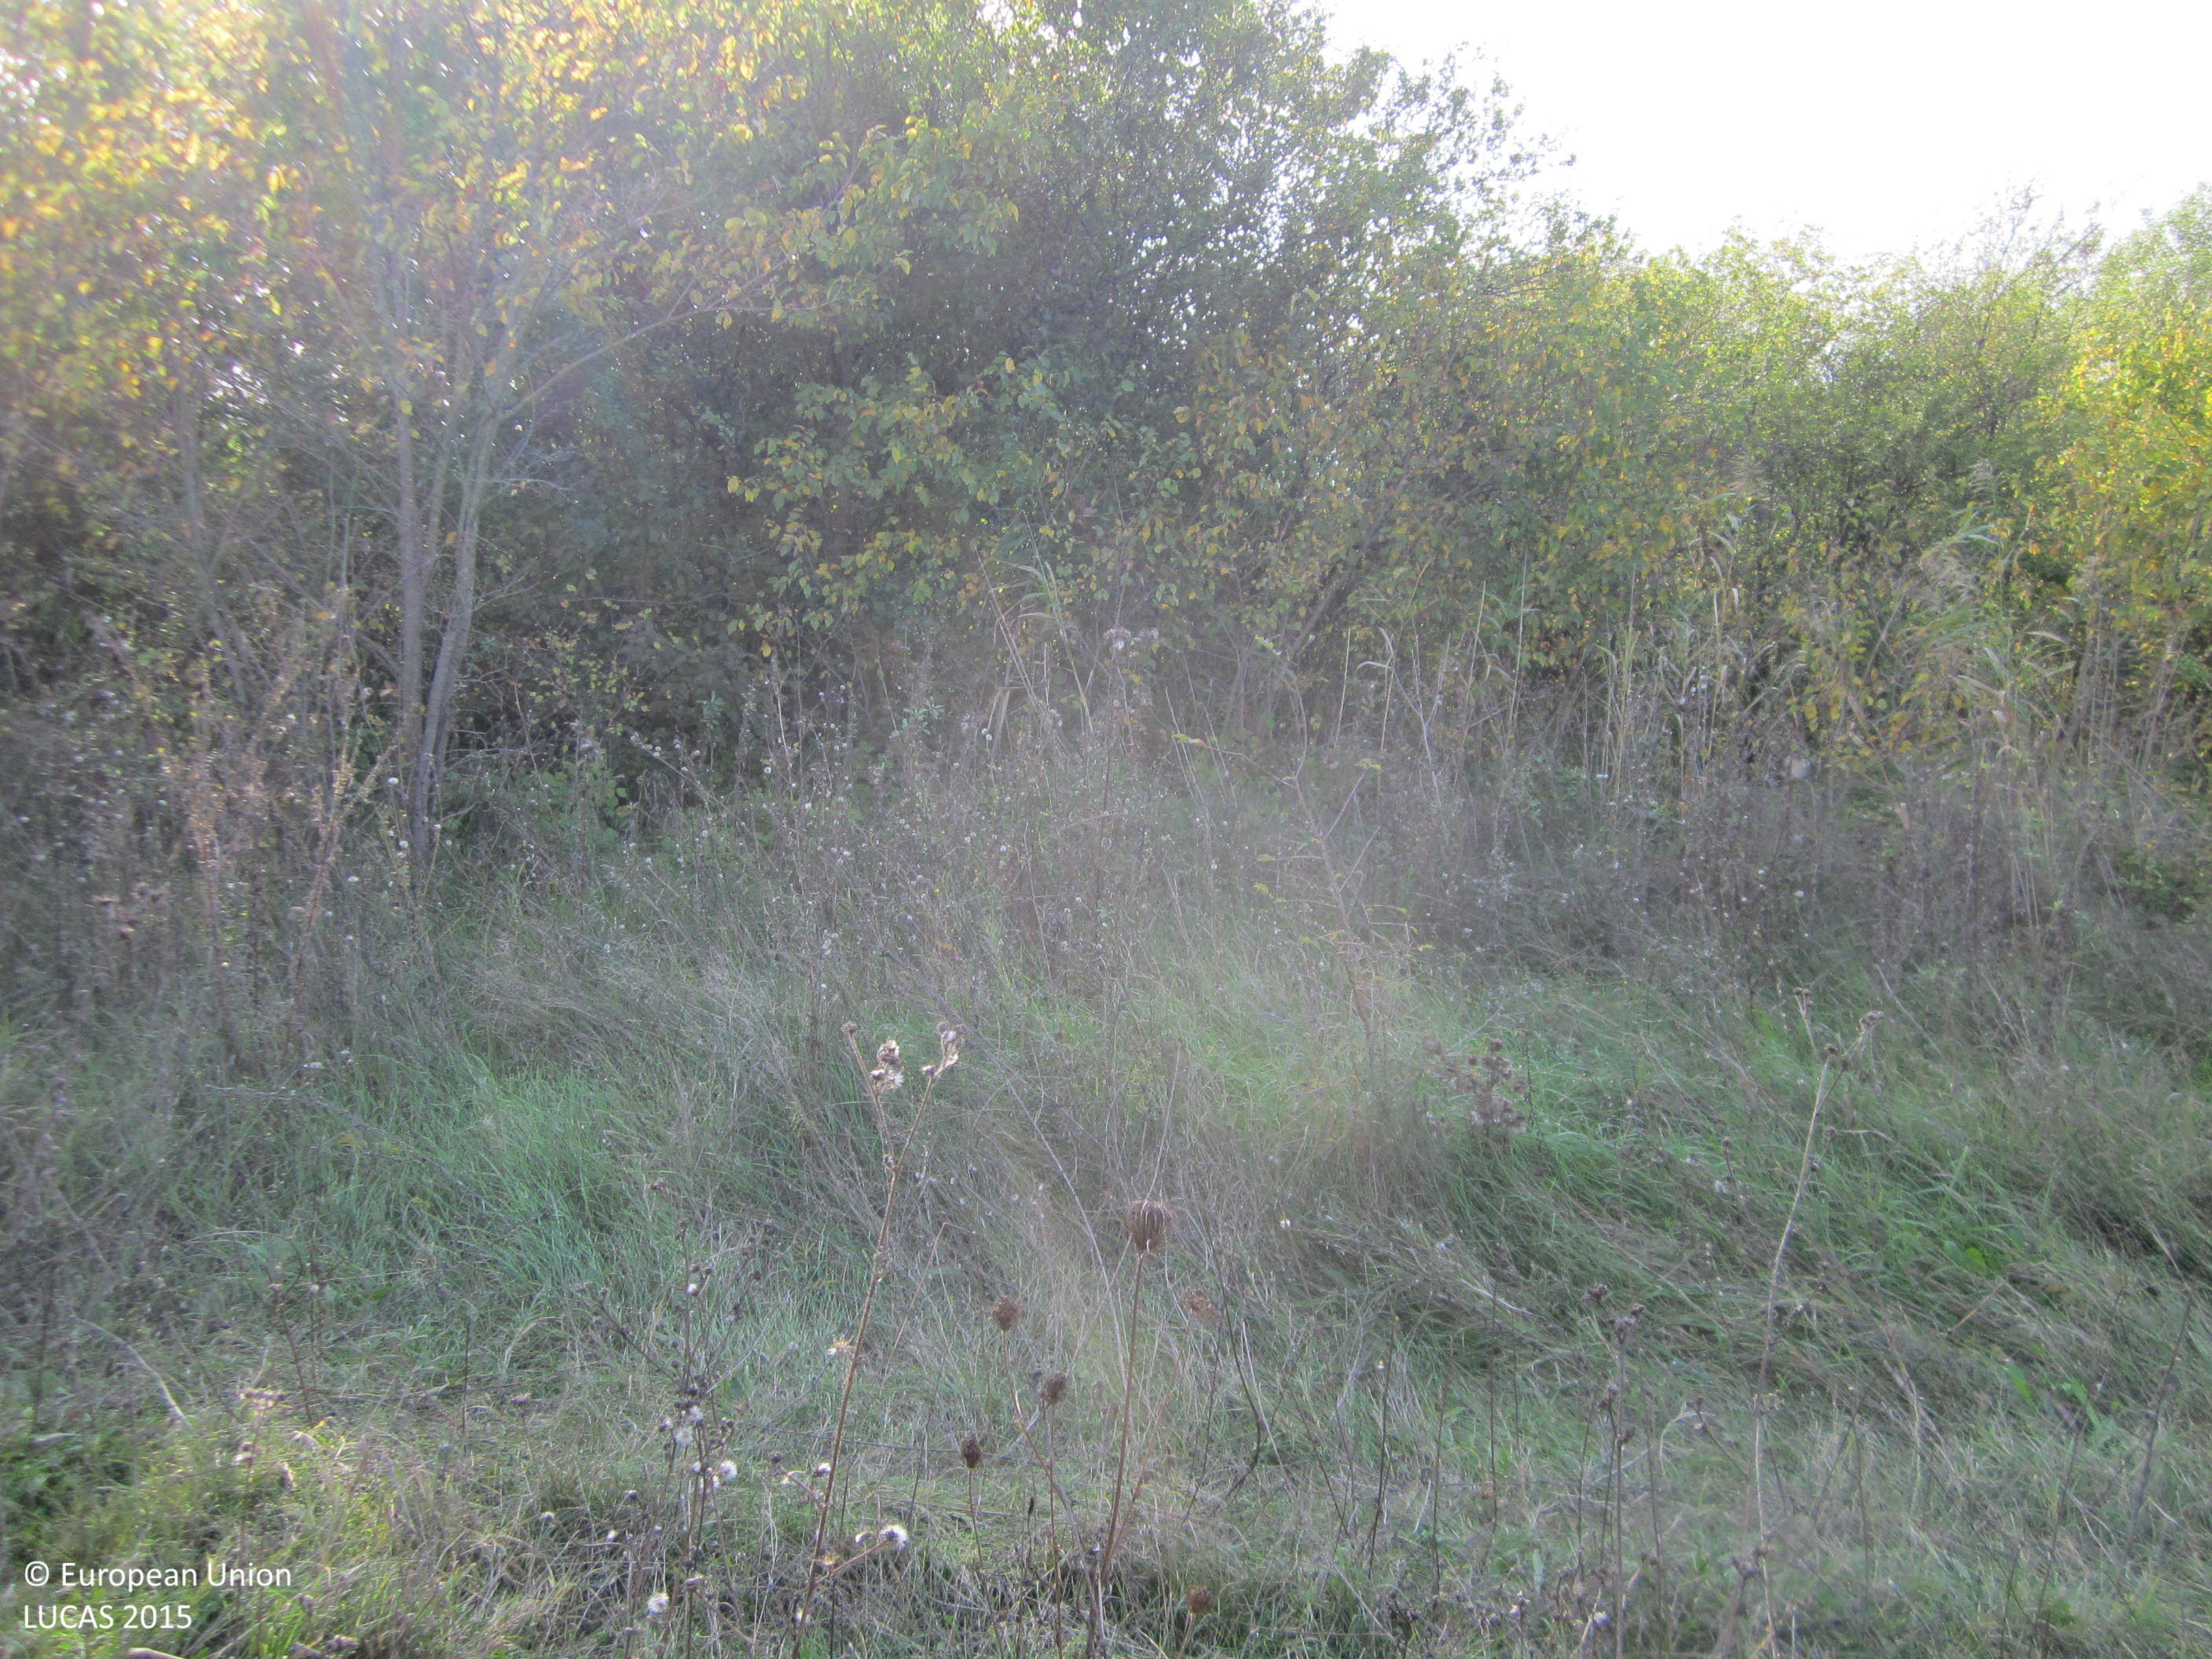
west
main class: Woodland
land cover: Broadleaved woodland
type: mesophytic deciduous forest
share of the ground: 25 - 50 %
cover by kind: herbaceous plants 40 %, broadleaved forest trees 30 %, shrubs 30 %
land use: Semi-natural and natural areas not in use
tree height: > 5 m
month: October
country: BG
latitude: 42.7340
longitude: 26.7744
